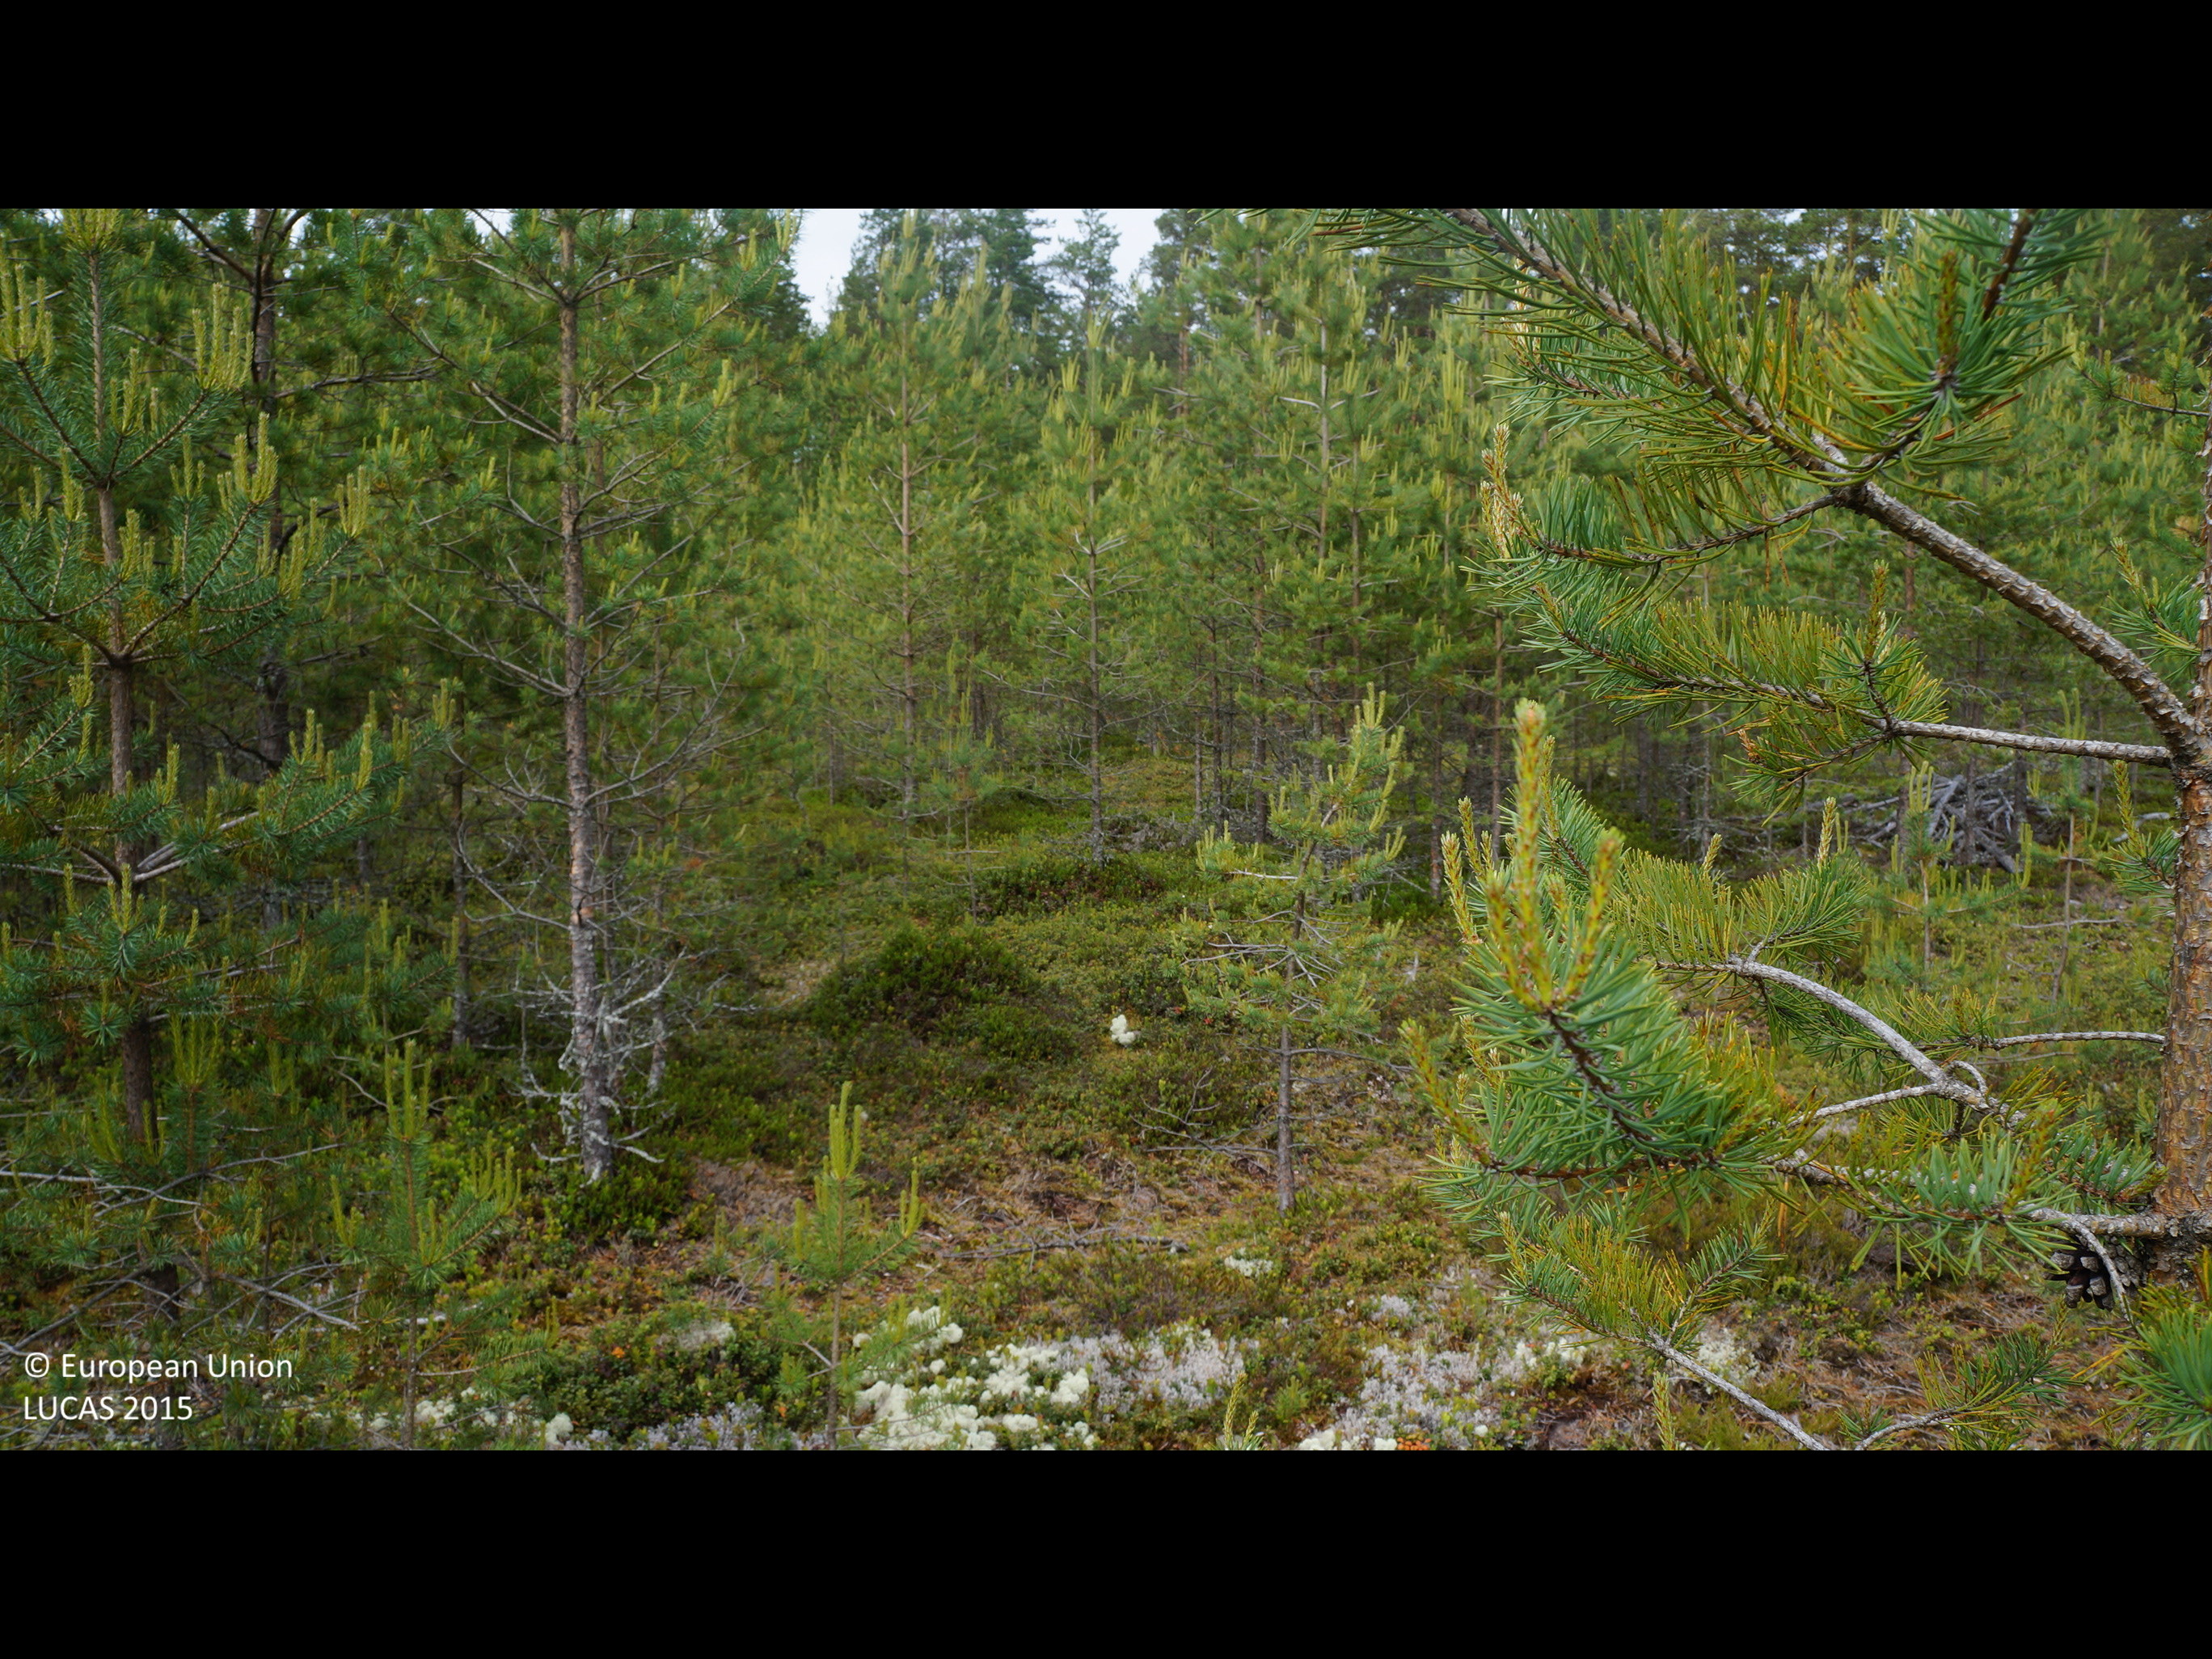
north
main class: Woodland
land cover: Pine dominated coniferous woodland
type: boreal forest
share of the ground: 25 - 50 %
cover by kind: coniferous forest trees 40 %, shrubs 40 %, lichens and mosses 20 %
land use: Forestry
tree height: > 5 m
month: June
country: FI
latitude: 63.8036
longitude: 23.0256
